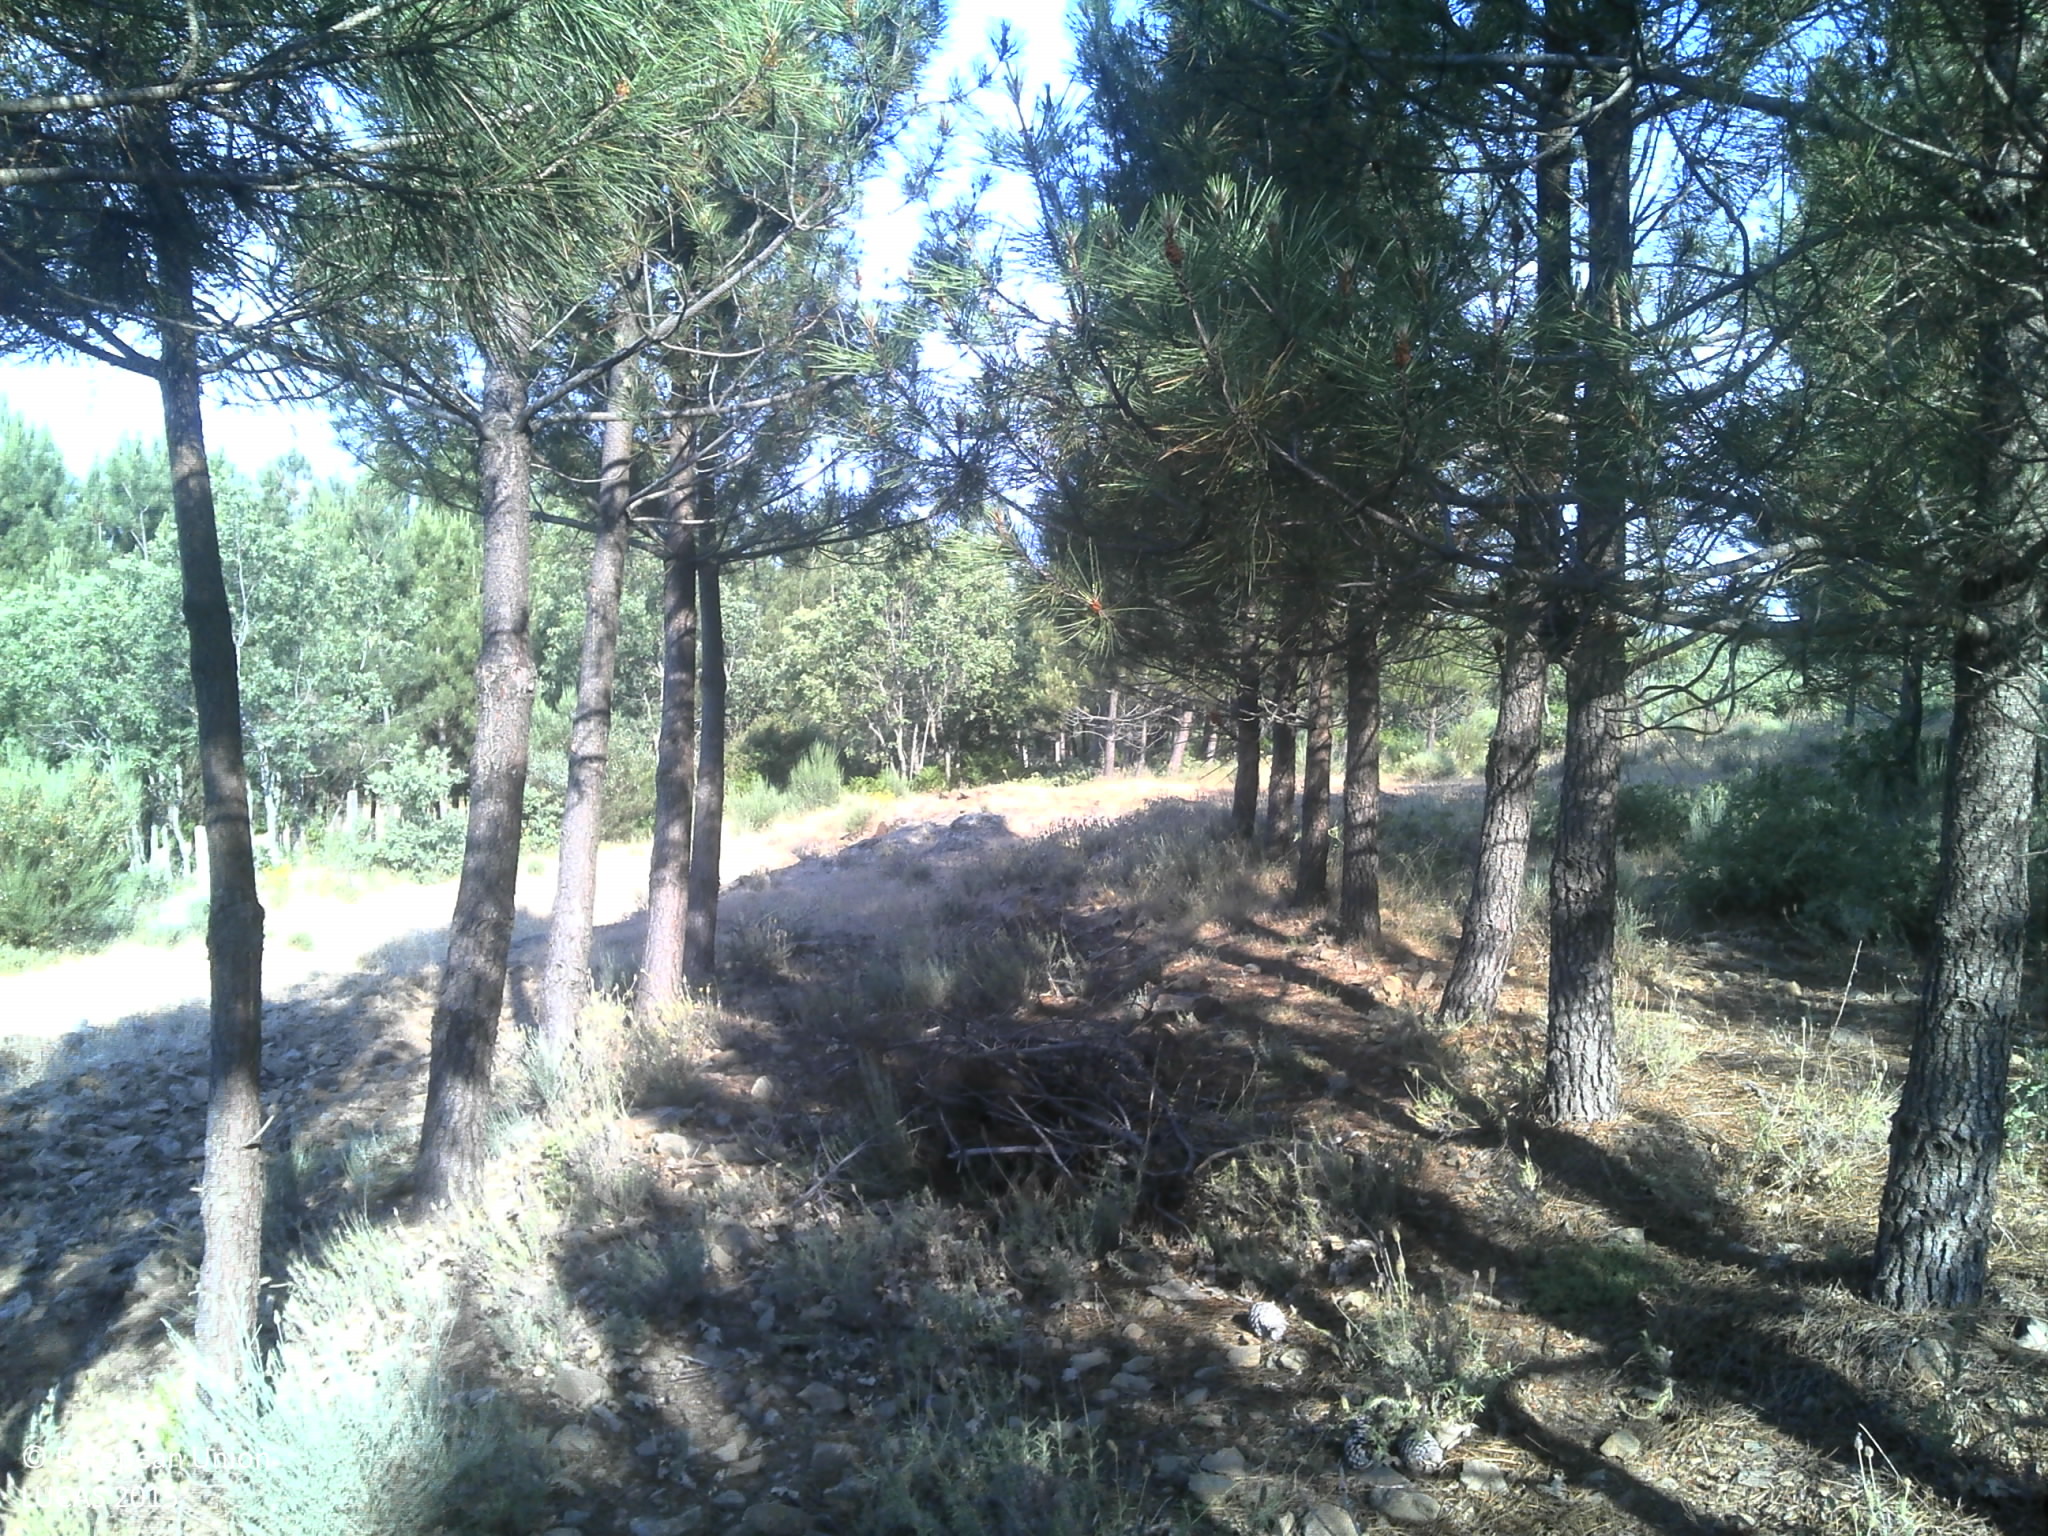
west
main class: Woodland
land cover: Pine dominated coniferous woodland
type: coniferous forest of the mediterranean region
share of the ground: 50 - 75 %
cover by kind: coniferous forest trees 65 %, unconsolidated bare surface 30 %, shrubs 5 %
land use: Forestry
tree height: > 5 m
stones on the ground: 10 - 25 %
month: June
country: PT
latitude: 40.3365
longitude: -7.0117
